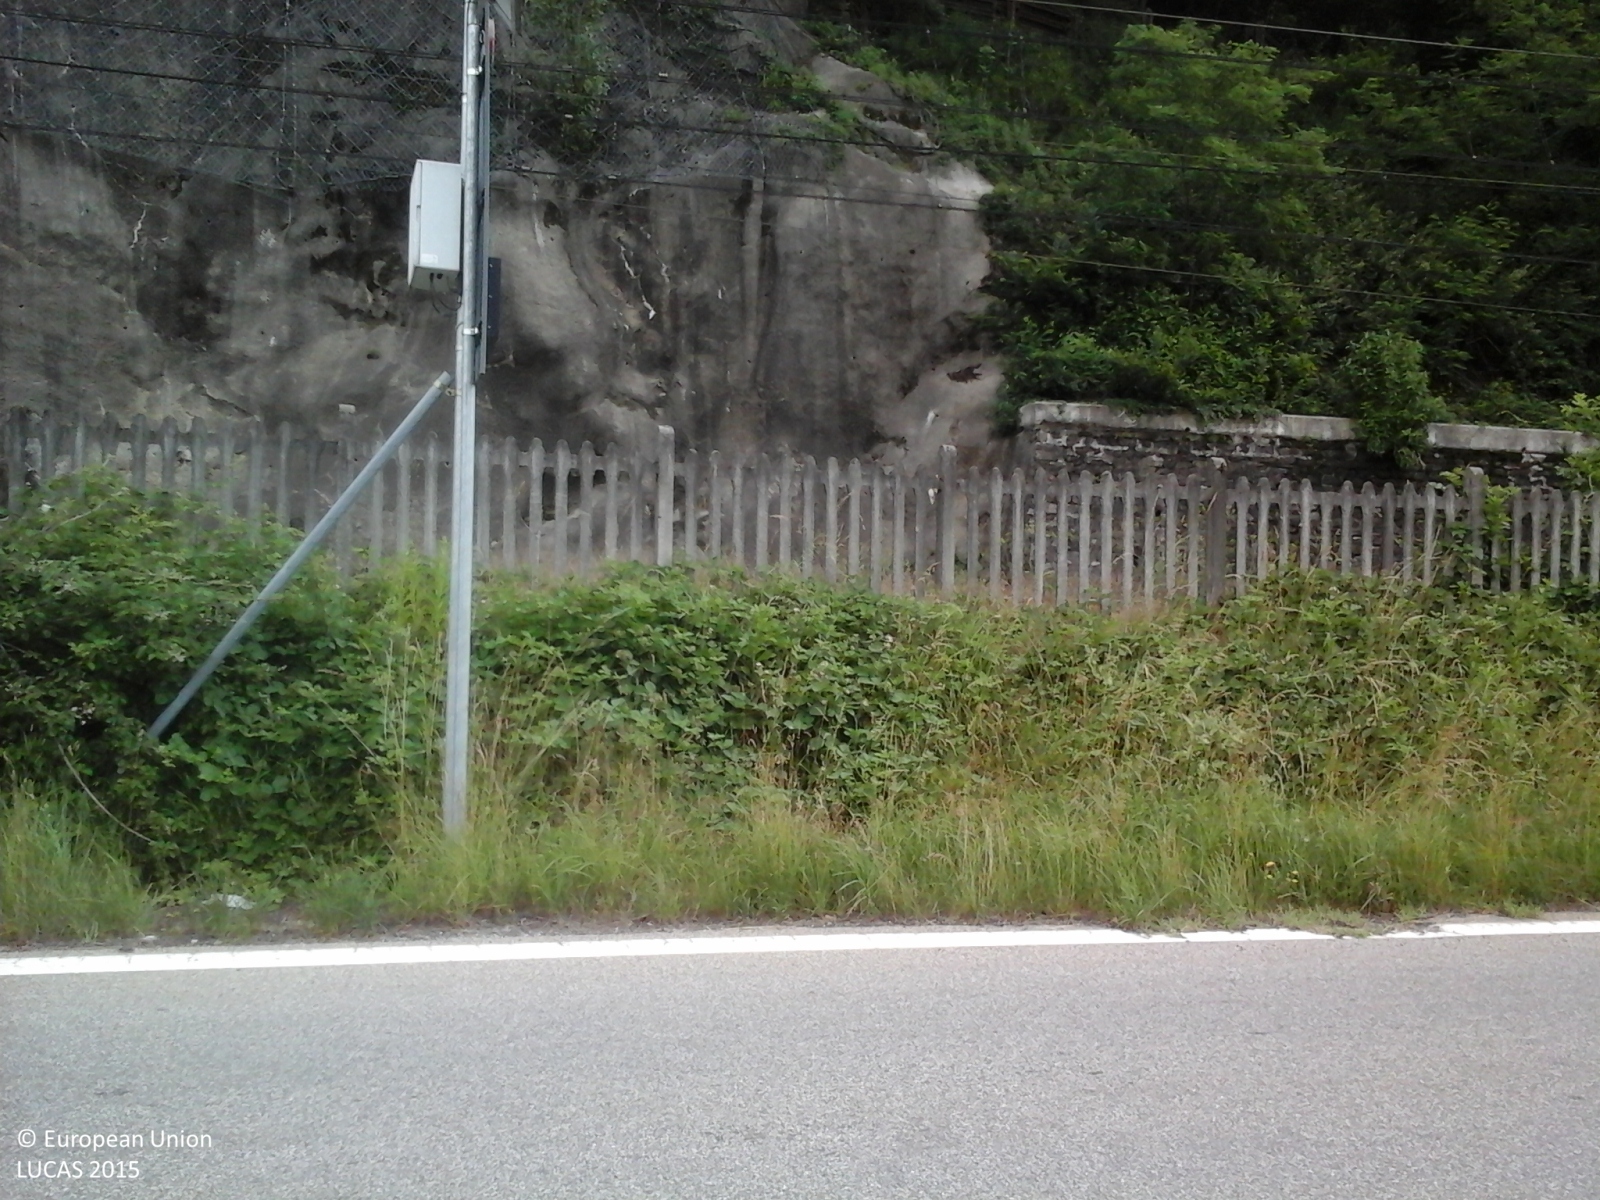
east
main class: Woodland
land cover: Broadleaved woodland
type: floodplain forest
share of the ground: > 75 %
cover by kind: broadleaved forest trees 100 %
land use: Semi-natural and natural areas not in use
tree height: > 5 m
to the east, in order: Broadleaved woodland; Paved roads, cycling and walking lanes; Railways; Other mixed woodland
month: June
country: IT
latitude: 46.0311
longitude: 8.2841
